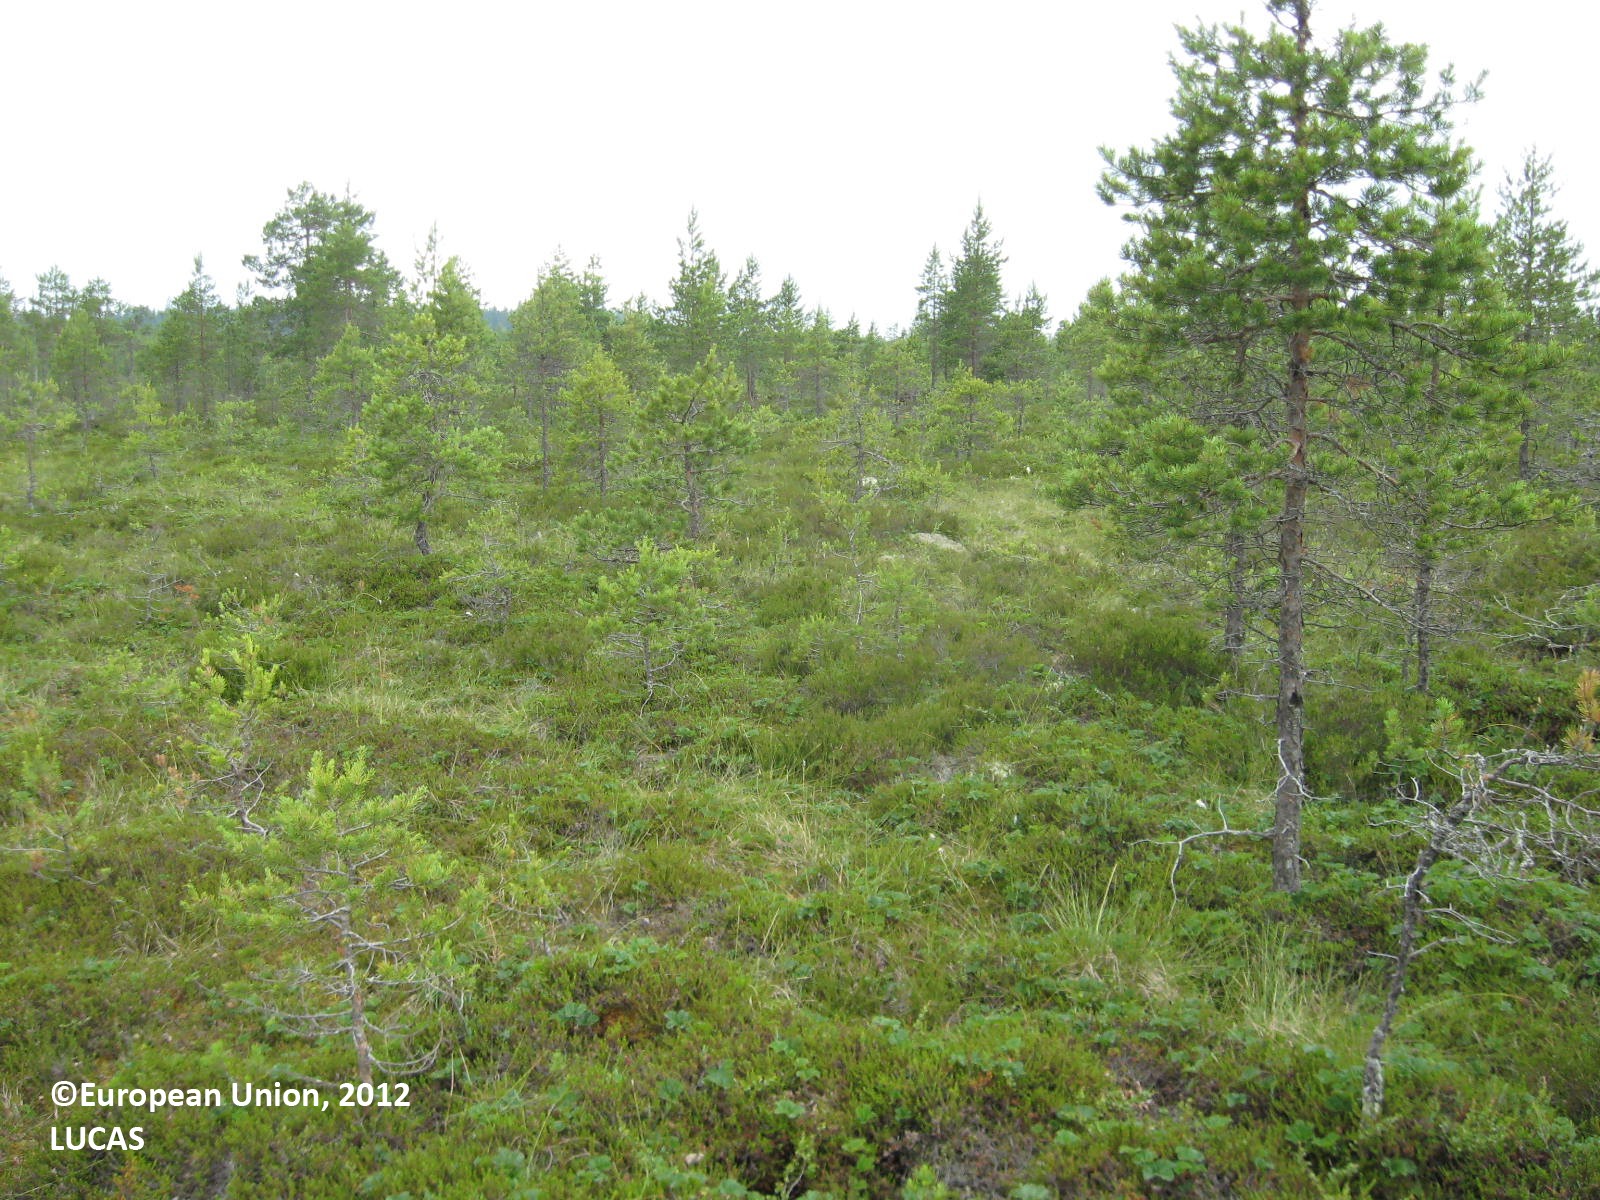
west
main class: Woodland
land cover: Pine dominated coniferous woodland
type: mire and swamp forests
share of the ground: 10 - 25 %
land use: Semi-natural and natural areas not in use
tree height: < 5 m
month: July
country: FI
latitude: 62.5065
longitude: 22.5412
